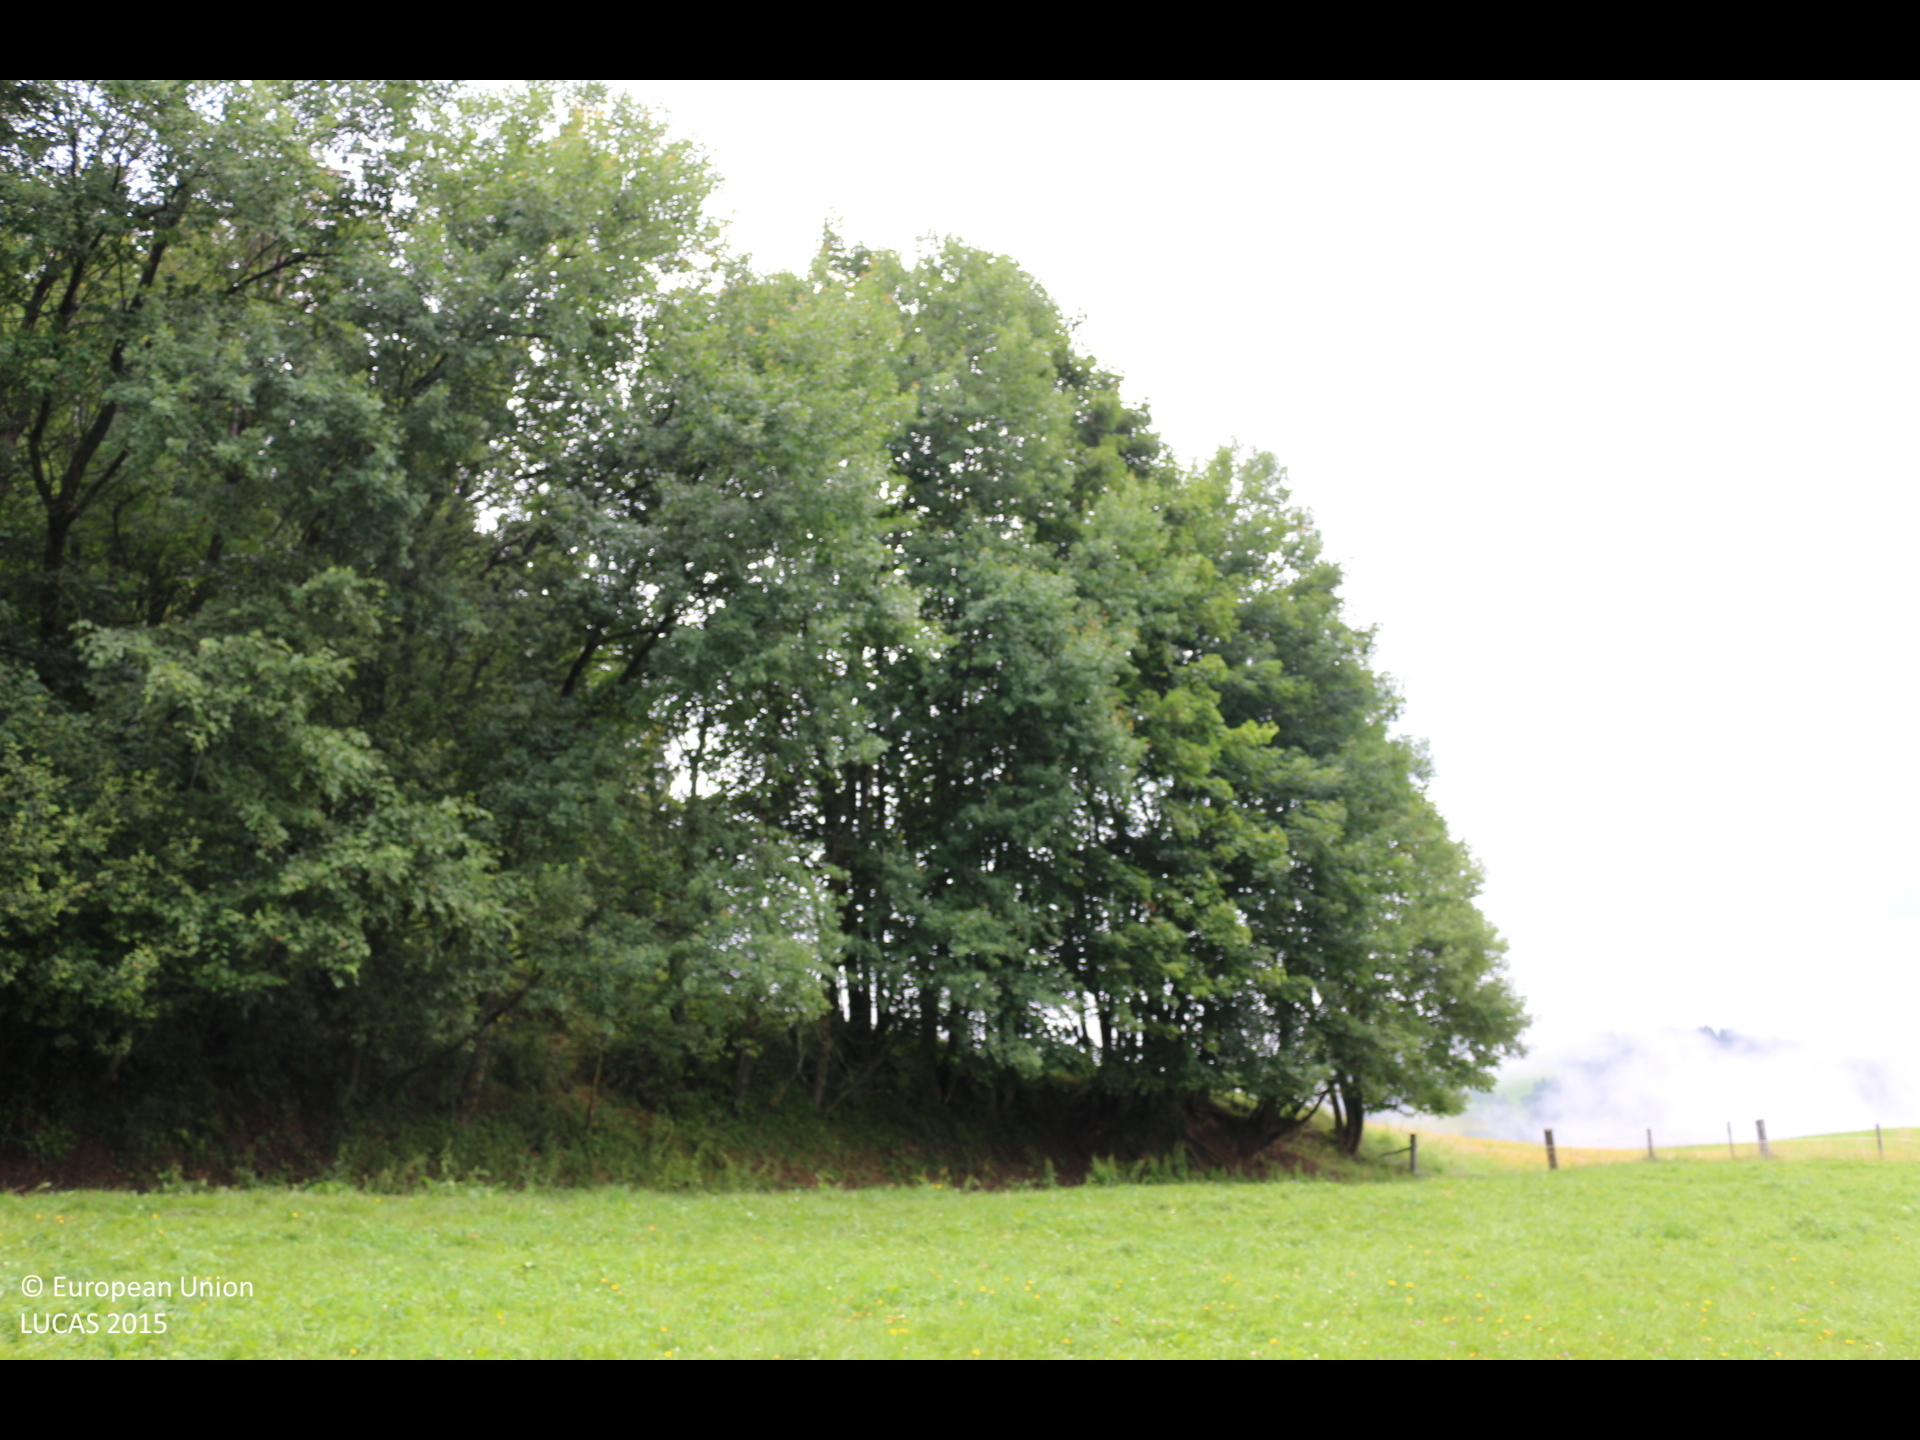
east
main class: Grassland
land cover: Grassland without tree/shrub cover
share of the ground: > 75 %
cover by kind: herbaceous plants 100 %
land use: Agriculture (excluding fallow land and kitchen gardens)
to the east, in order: Grassland without tree/shrub cover; Broadleaved woodland; Fences; Grassland without tree/shrub cover
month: July
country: AT
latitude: 46.9608
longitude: 14.4795
